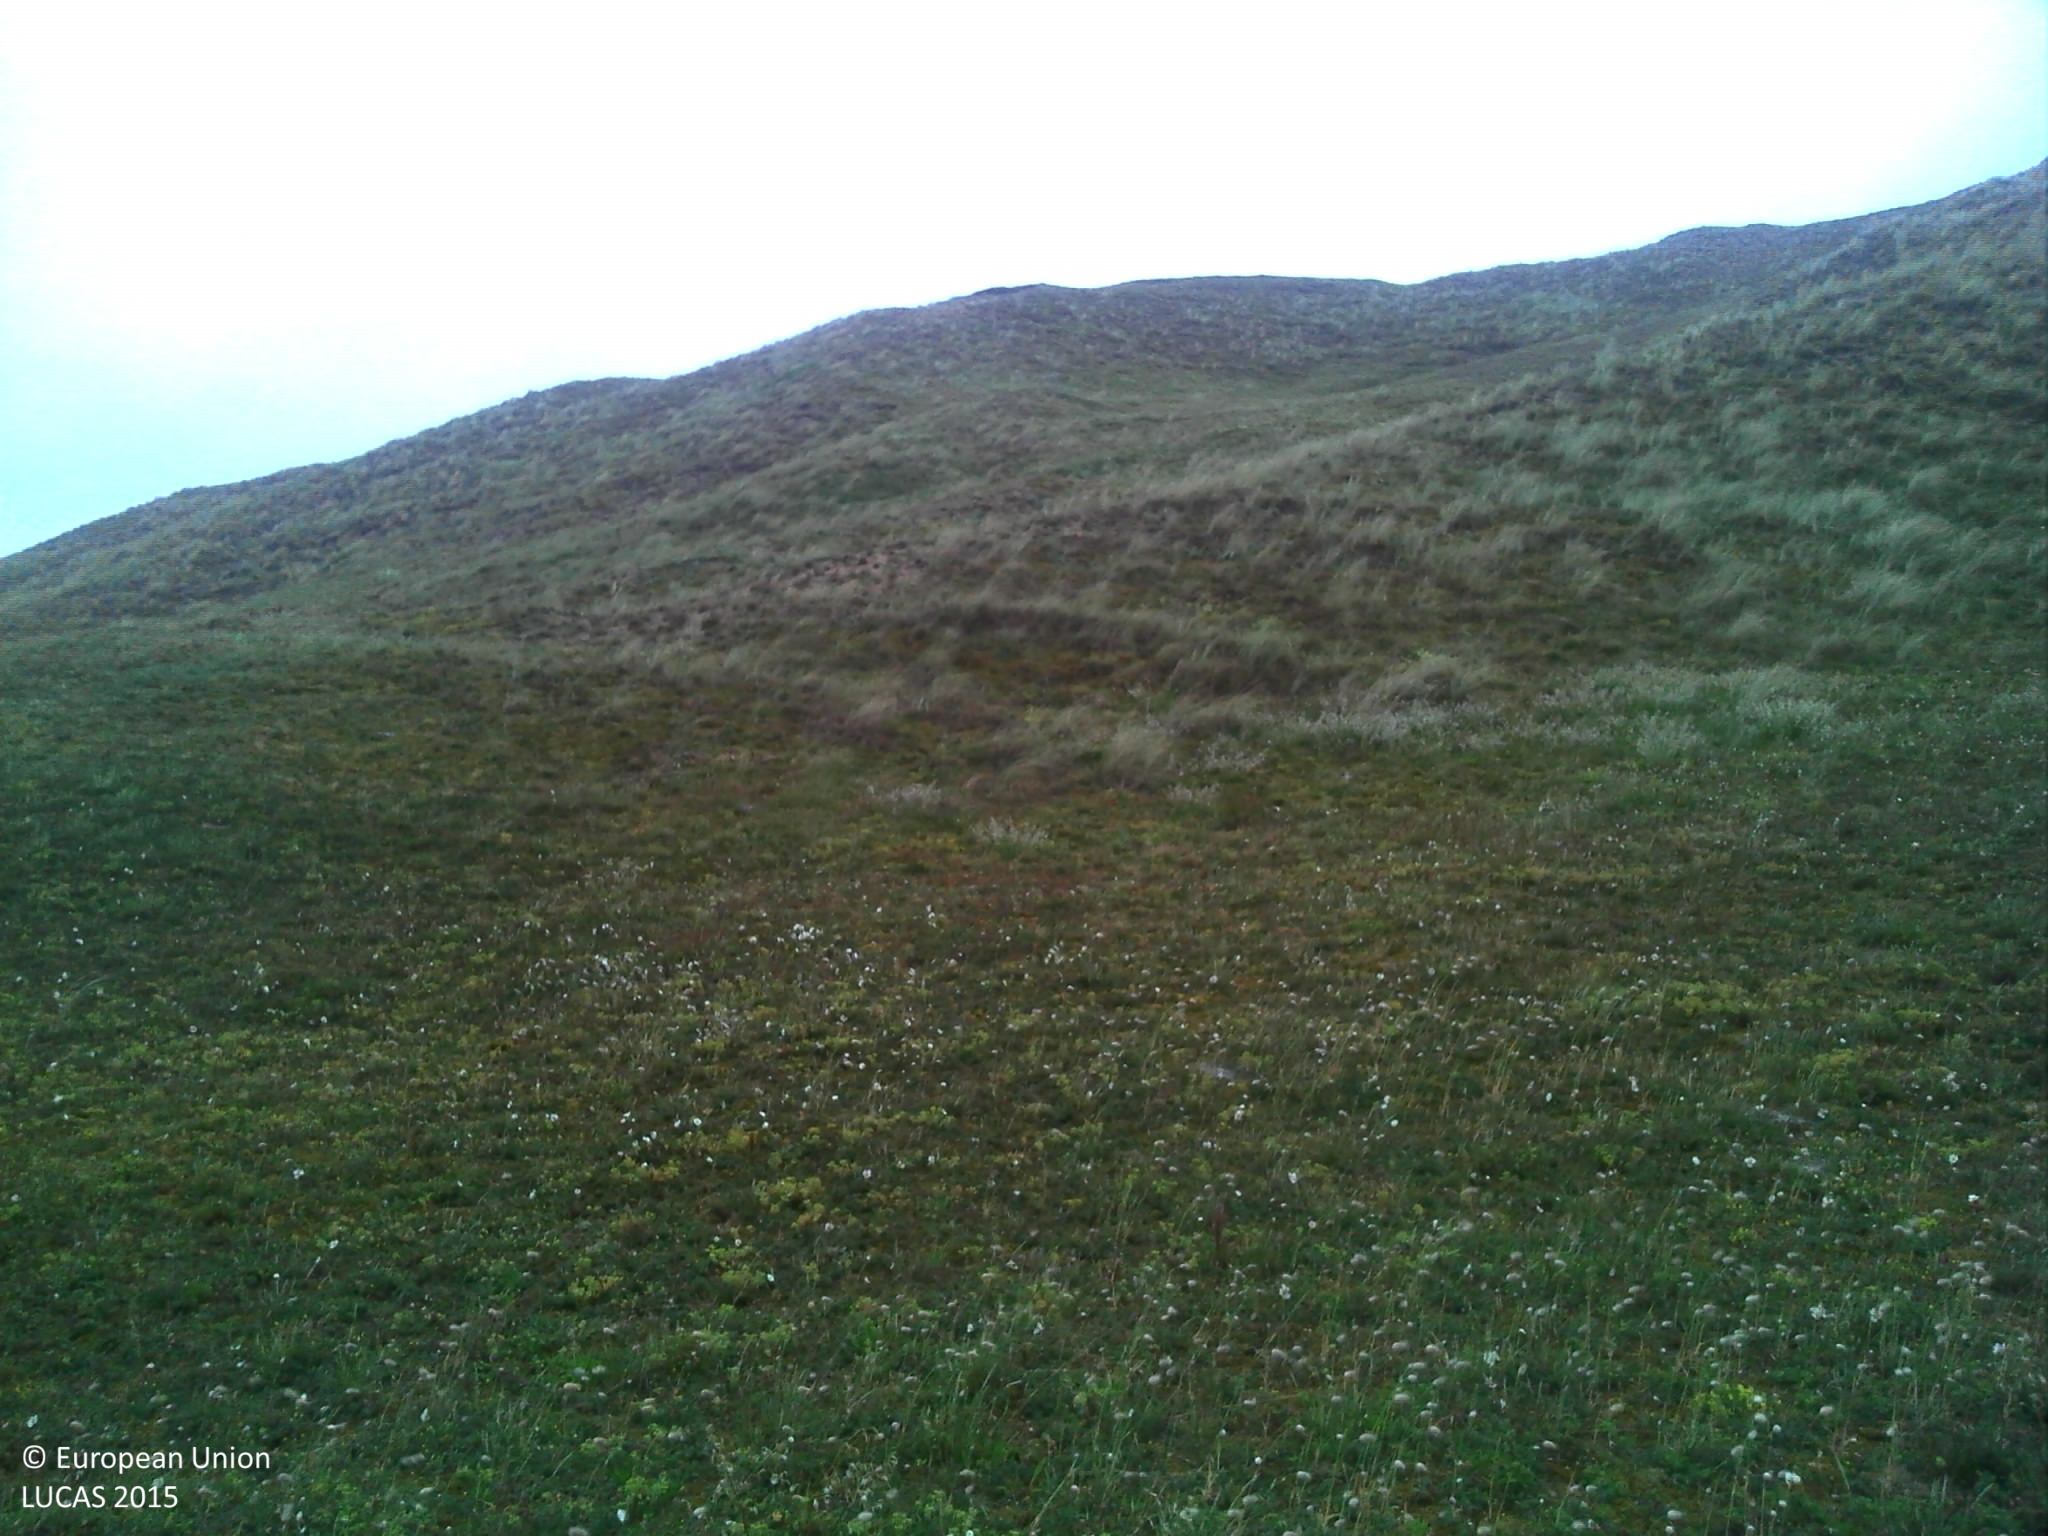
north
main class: Grassland
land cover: Spontaneously vegetated surfaces
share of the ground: > 75 %
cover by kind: herbaceous plants 100 %
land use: Semi-natural and natural areas not in use
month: June
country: FR
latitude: 49.6022
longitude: -1.8295
